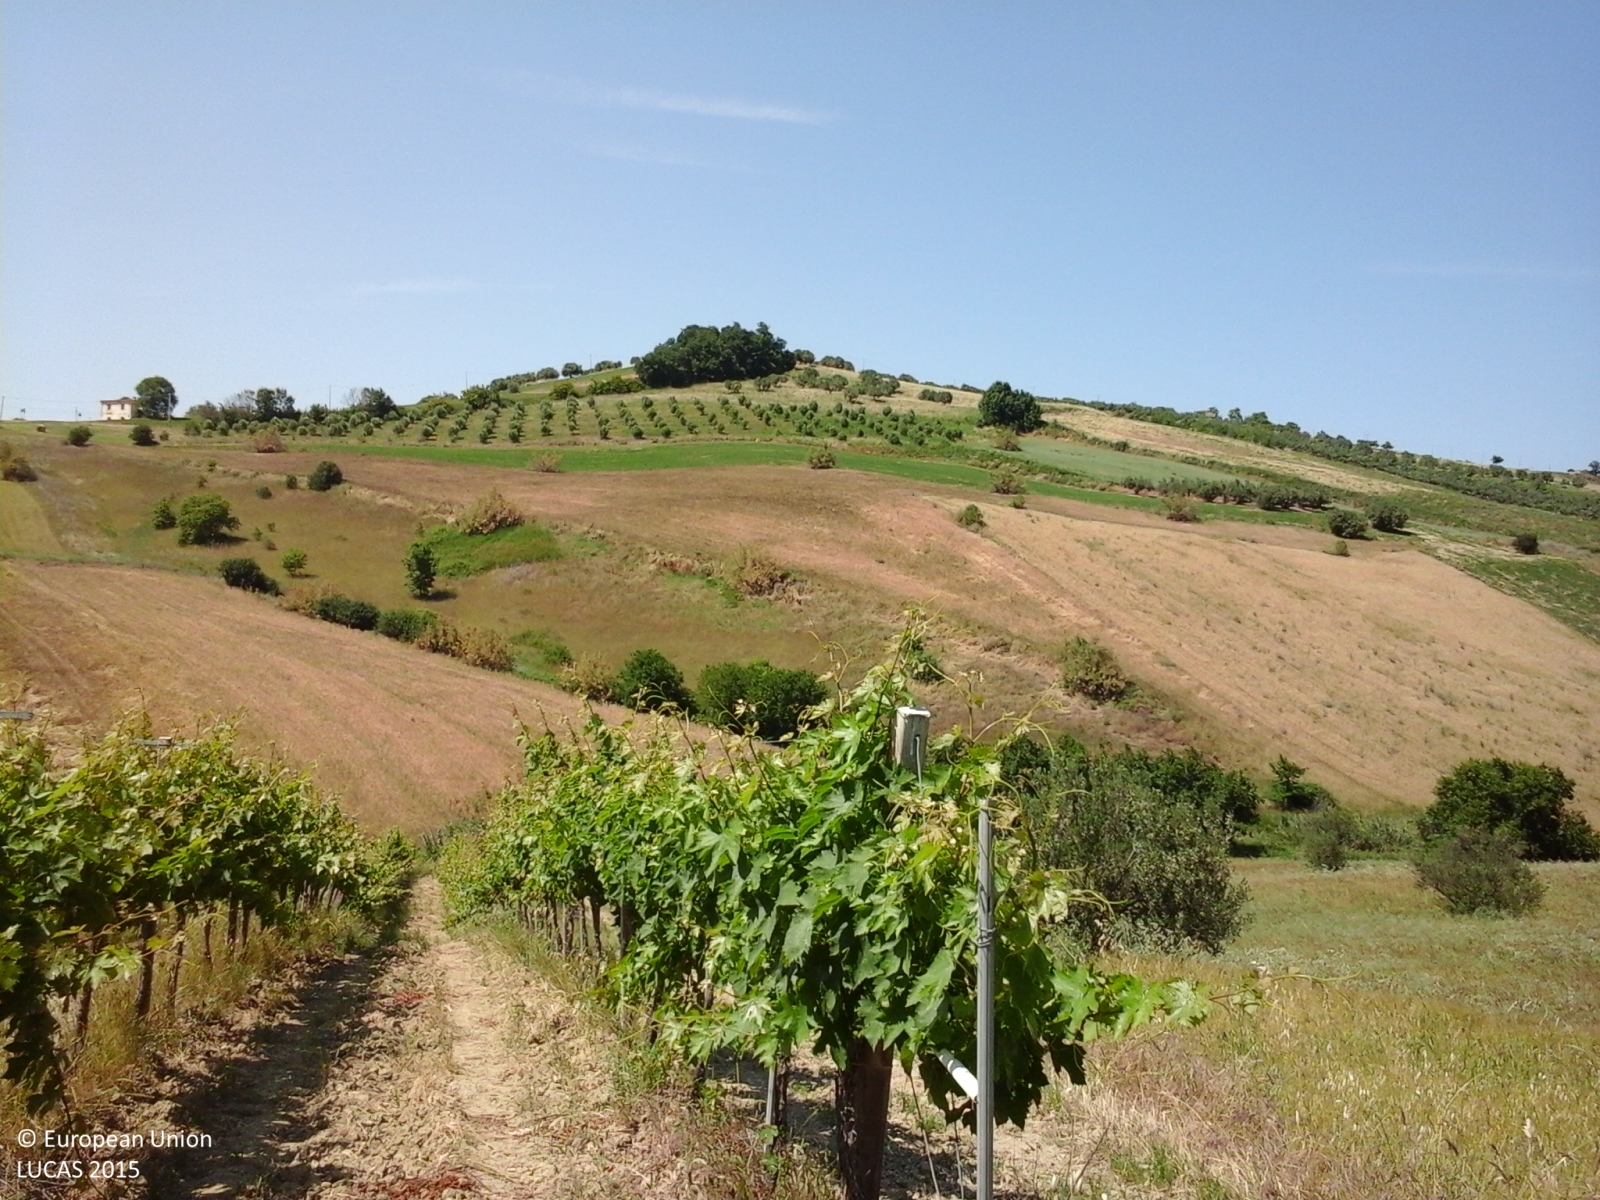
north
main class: Cropland
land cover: Vineyards
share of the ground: > 75 %
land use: Agriculture (excluding fallow land and kitchen gardens)
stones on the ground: < 10 %
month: May
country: IT
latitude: 42.1380
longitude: 14.4990
